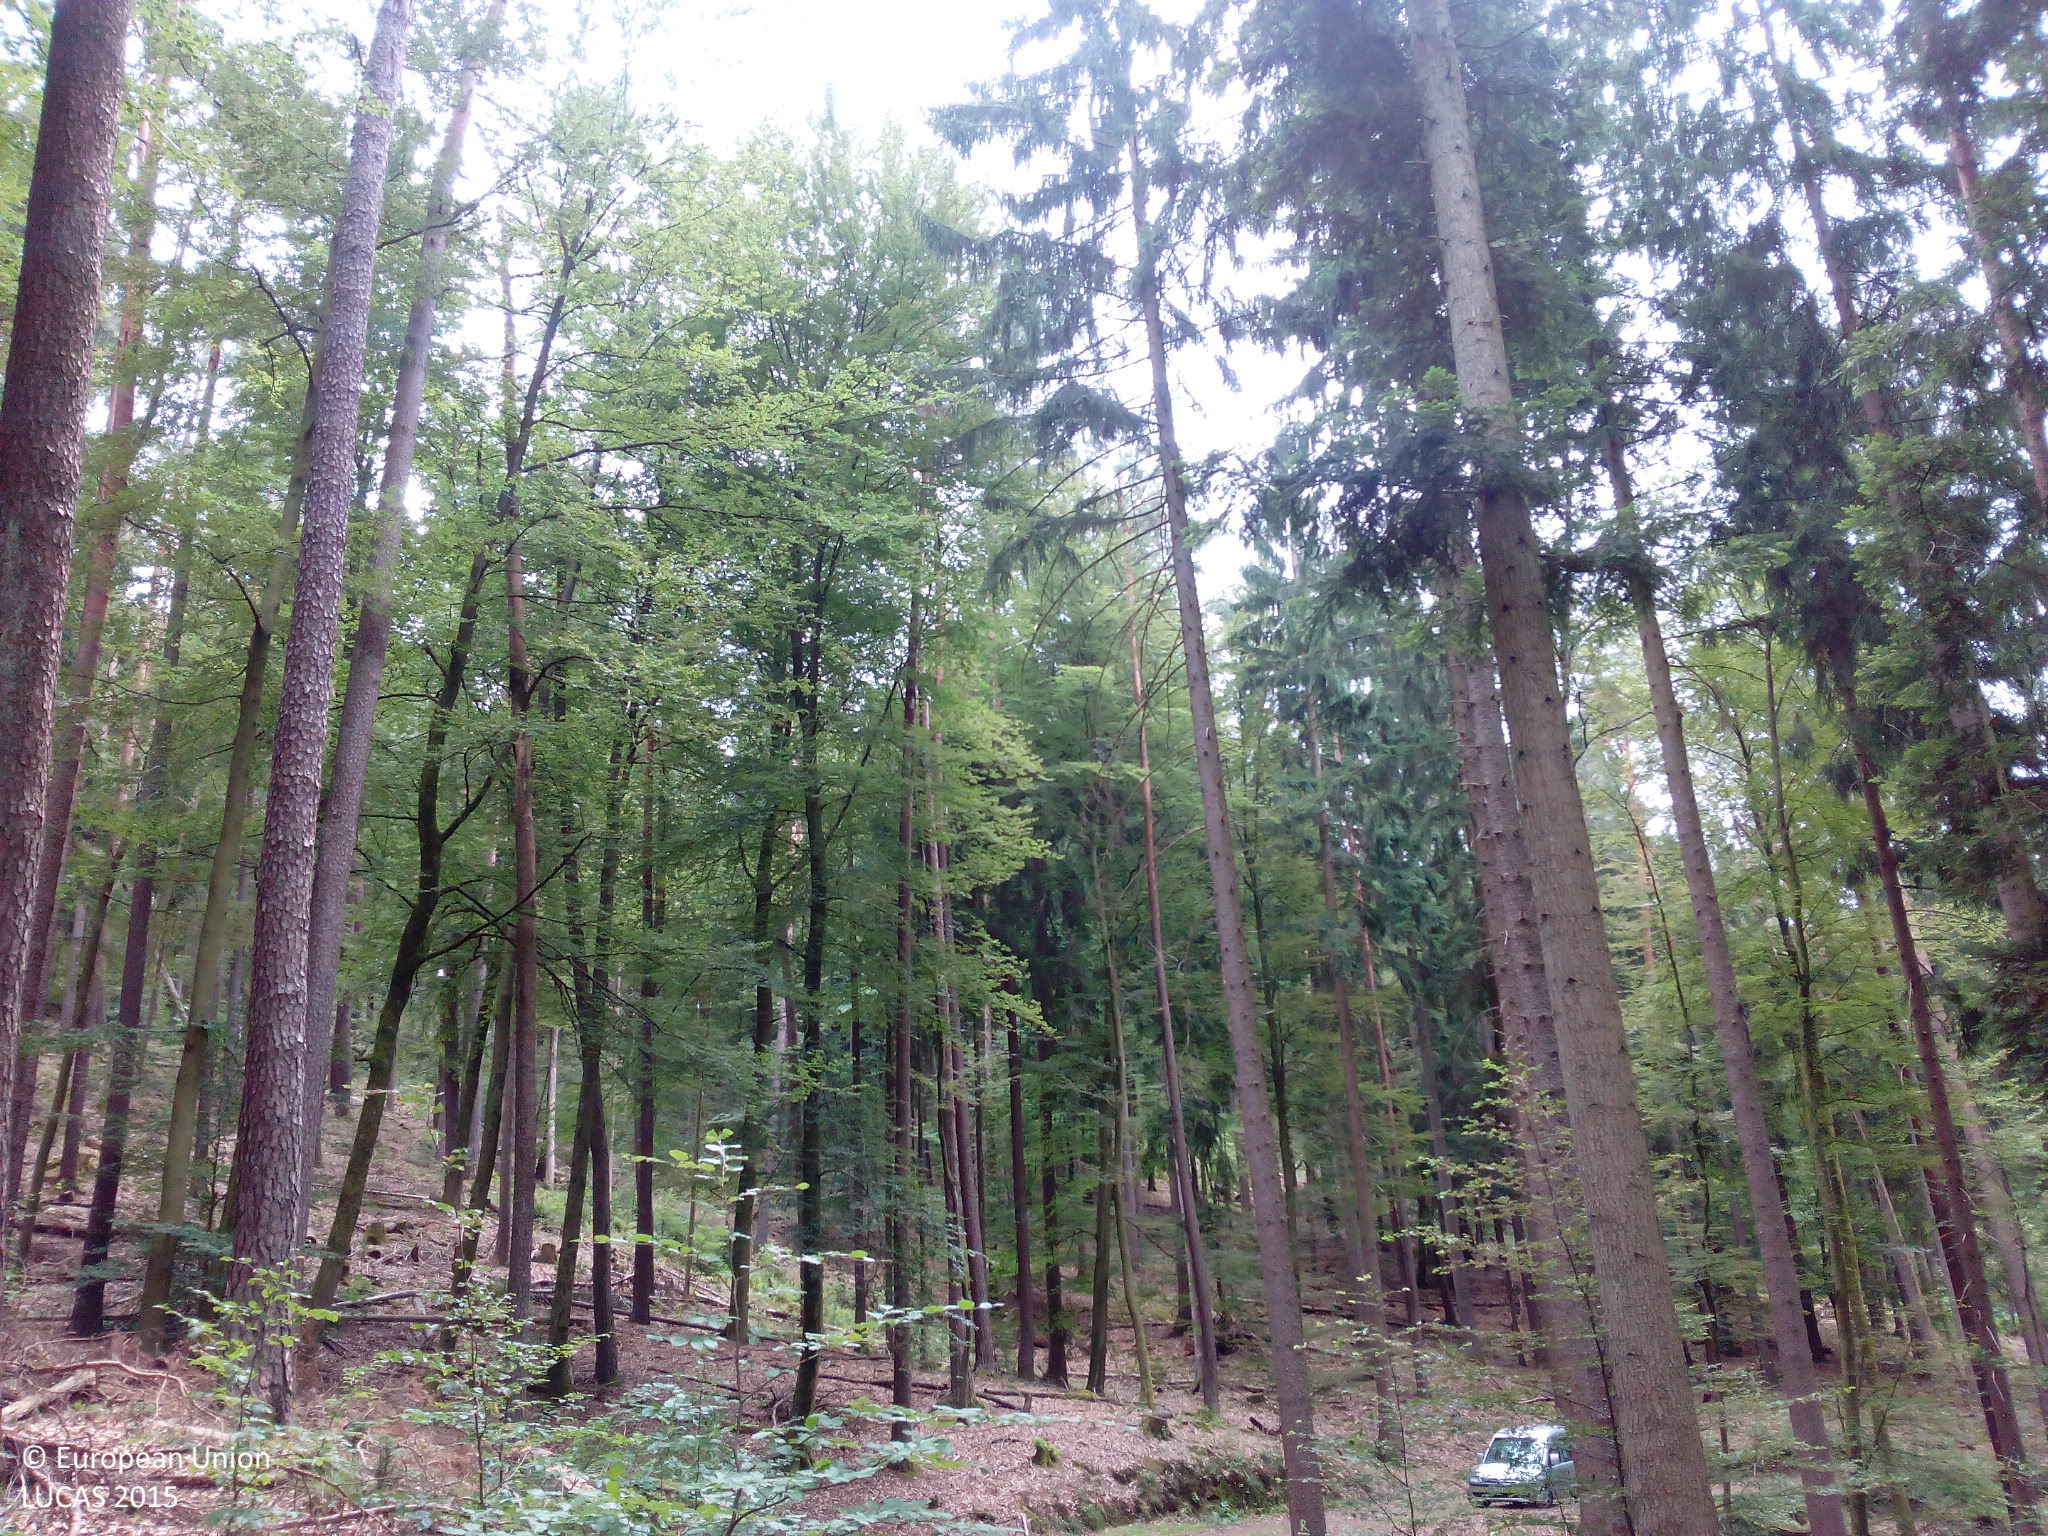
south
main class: Woodland
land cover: Other mixed woodland
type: hemiboreal forest and nemoral coniferous forest and mixed broadleaved-coniferous forest
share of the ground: > 75 %
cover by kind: coniferous forest trees 60 %, broadleaved forest trees 25 %, unconsolidated bare surface 10 %, herbaceous plants 5 %
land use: Forestry
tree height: > 5 m
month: July
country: DE
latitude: 49.1155
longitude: 7.6030
